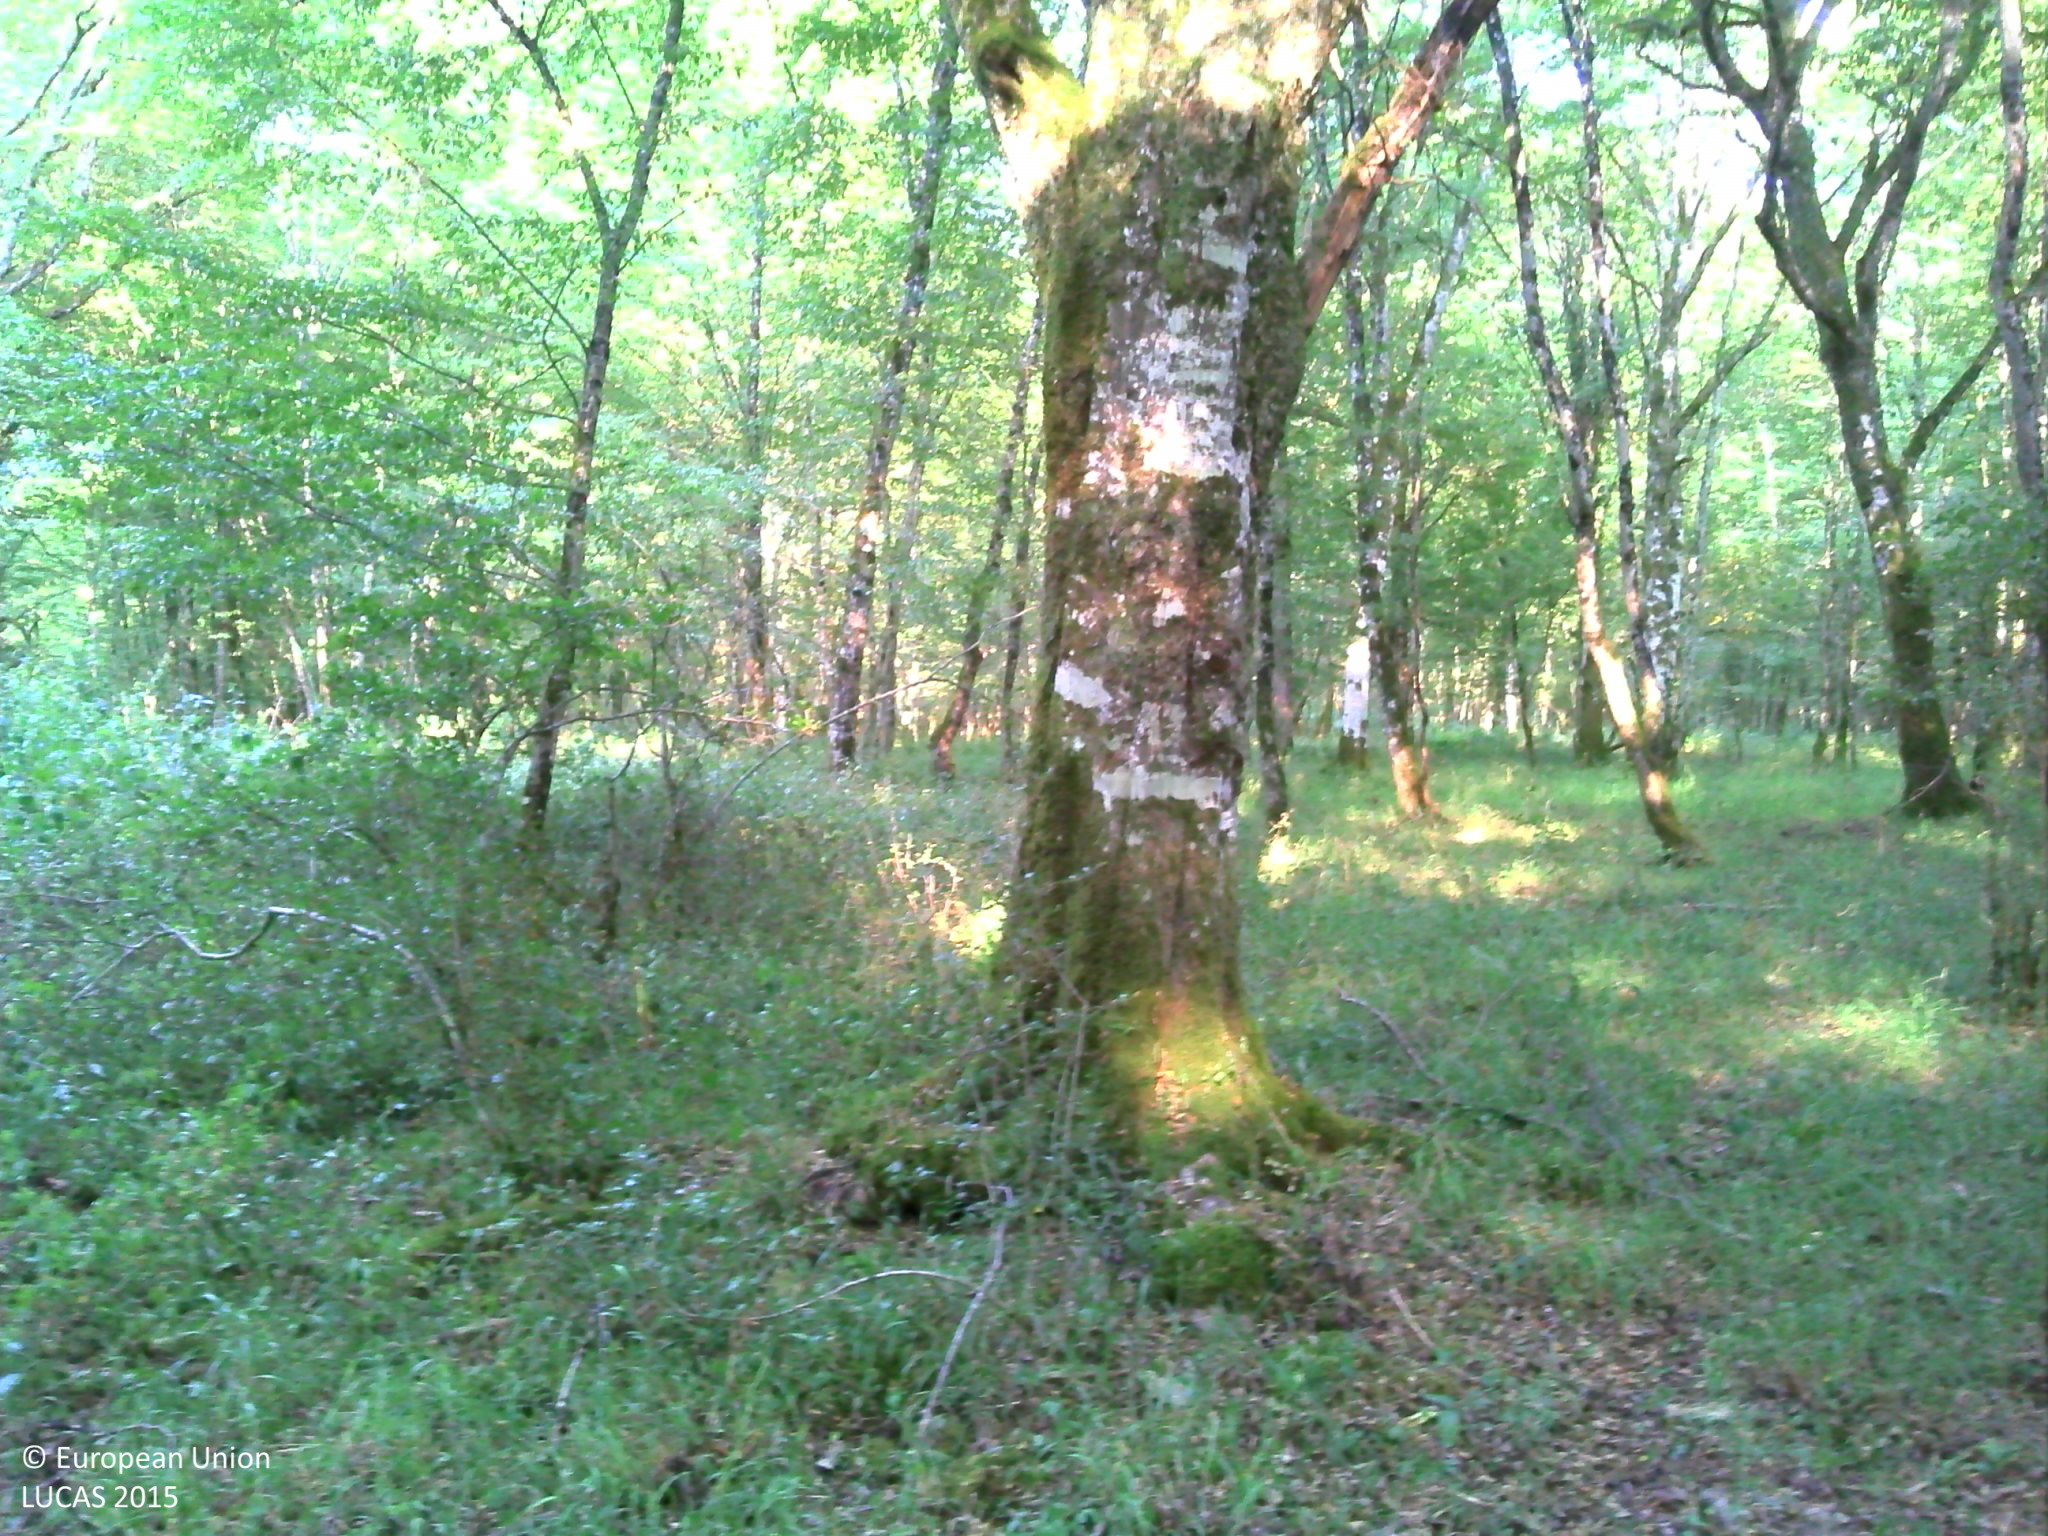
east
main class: Woodland
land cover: Broadleaved woodland
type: mesophytic deciduous forest
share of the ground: > 75 %
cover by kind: broadleaved forest trees 75 %, shrubs 10 %, lichens and mosses 10 %, herbaceous plants 5 %
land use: Forestry
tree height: > 5 m
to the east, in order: Broadleaved woodland; Tracks; Spruce dominated coniferous woodland
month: July
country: FR
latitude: 48.0199
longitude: 4.9980
